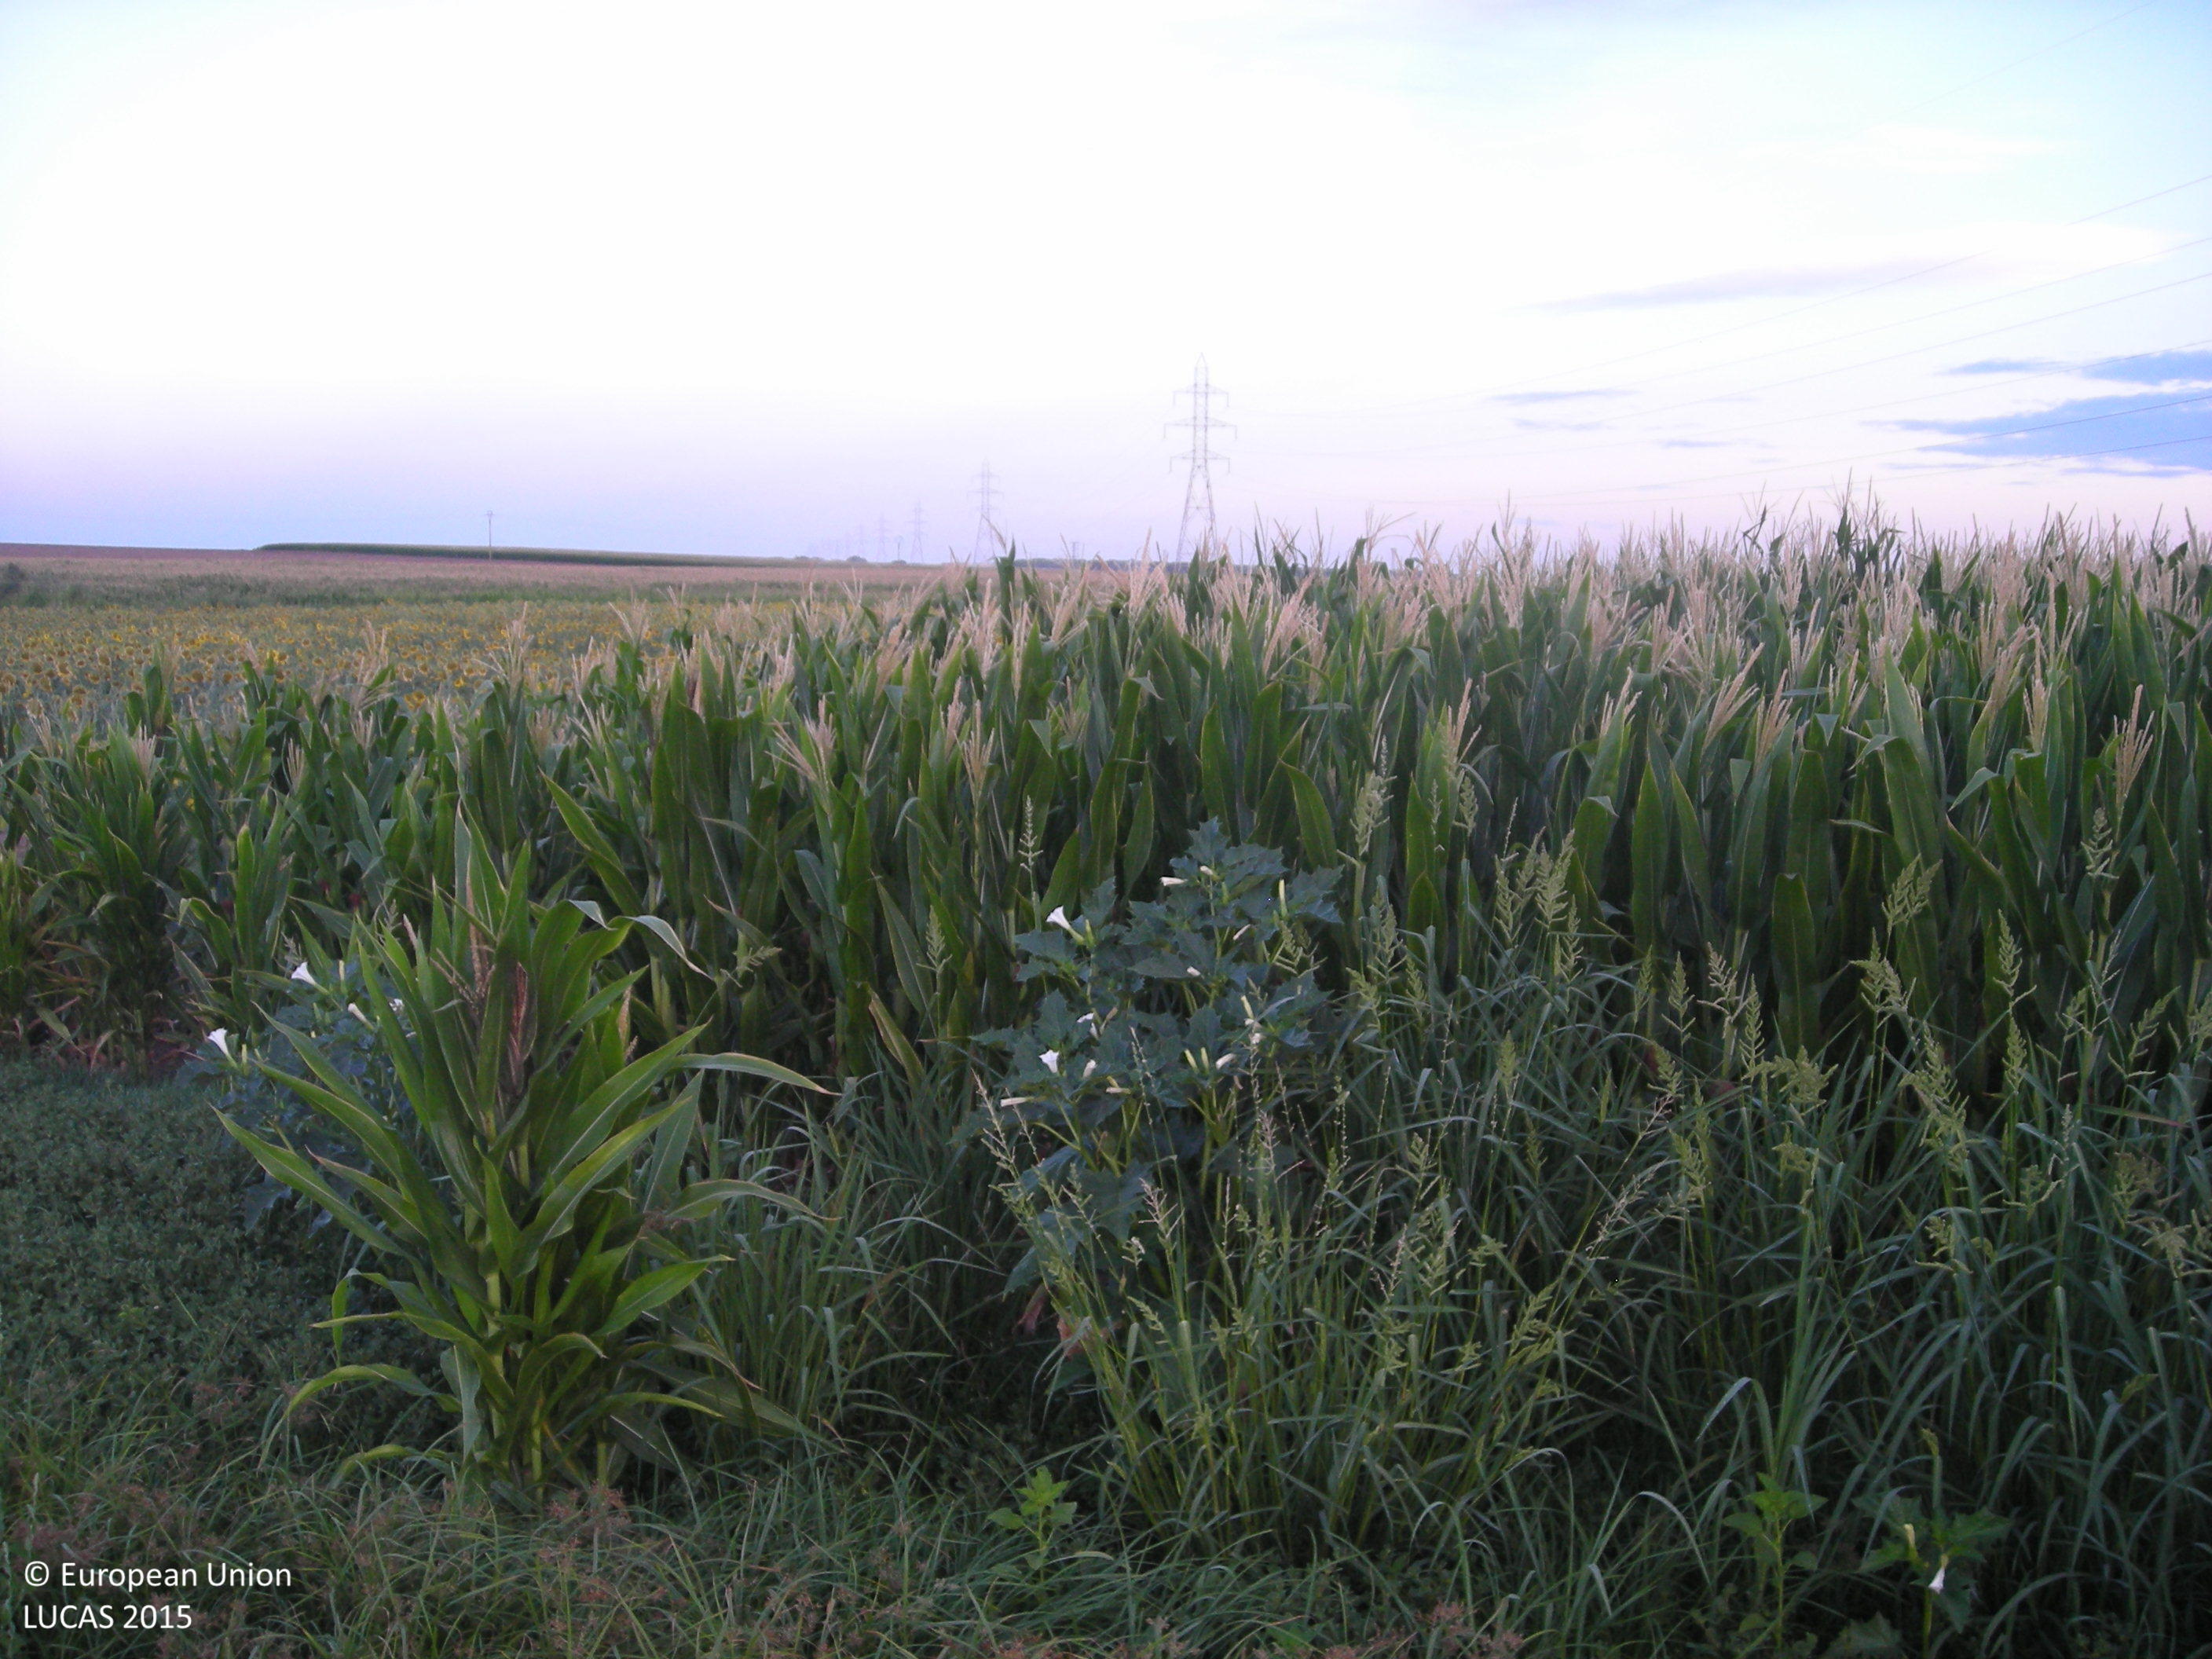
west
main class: Cropland
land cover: Rice
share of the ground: > 75 %
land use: Agriculture (excluding fallow land and kitchen gardens)
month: July
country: ES
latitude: 38.9230
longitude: -5.9092
